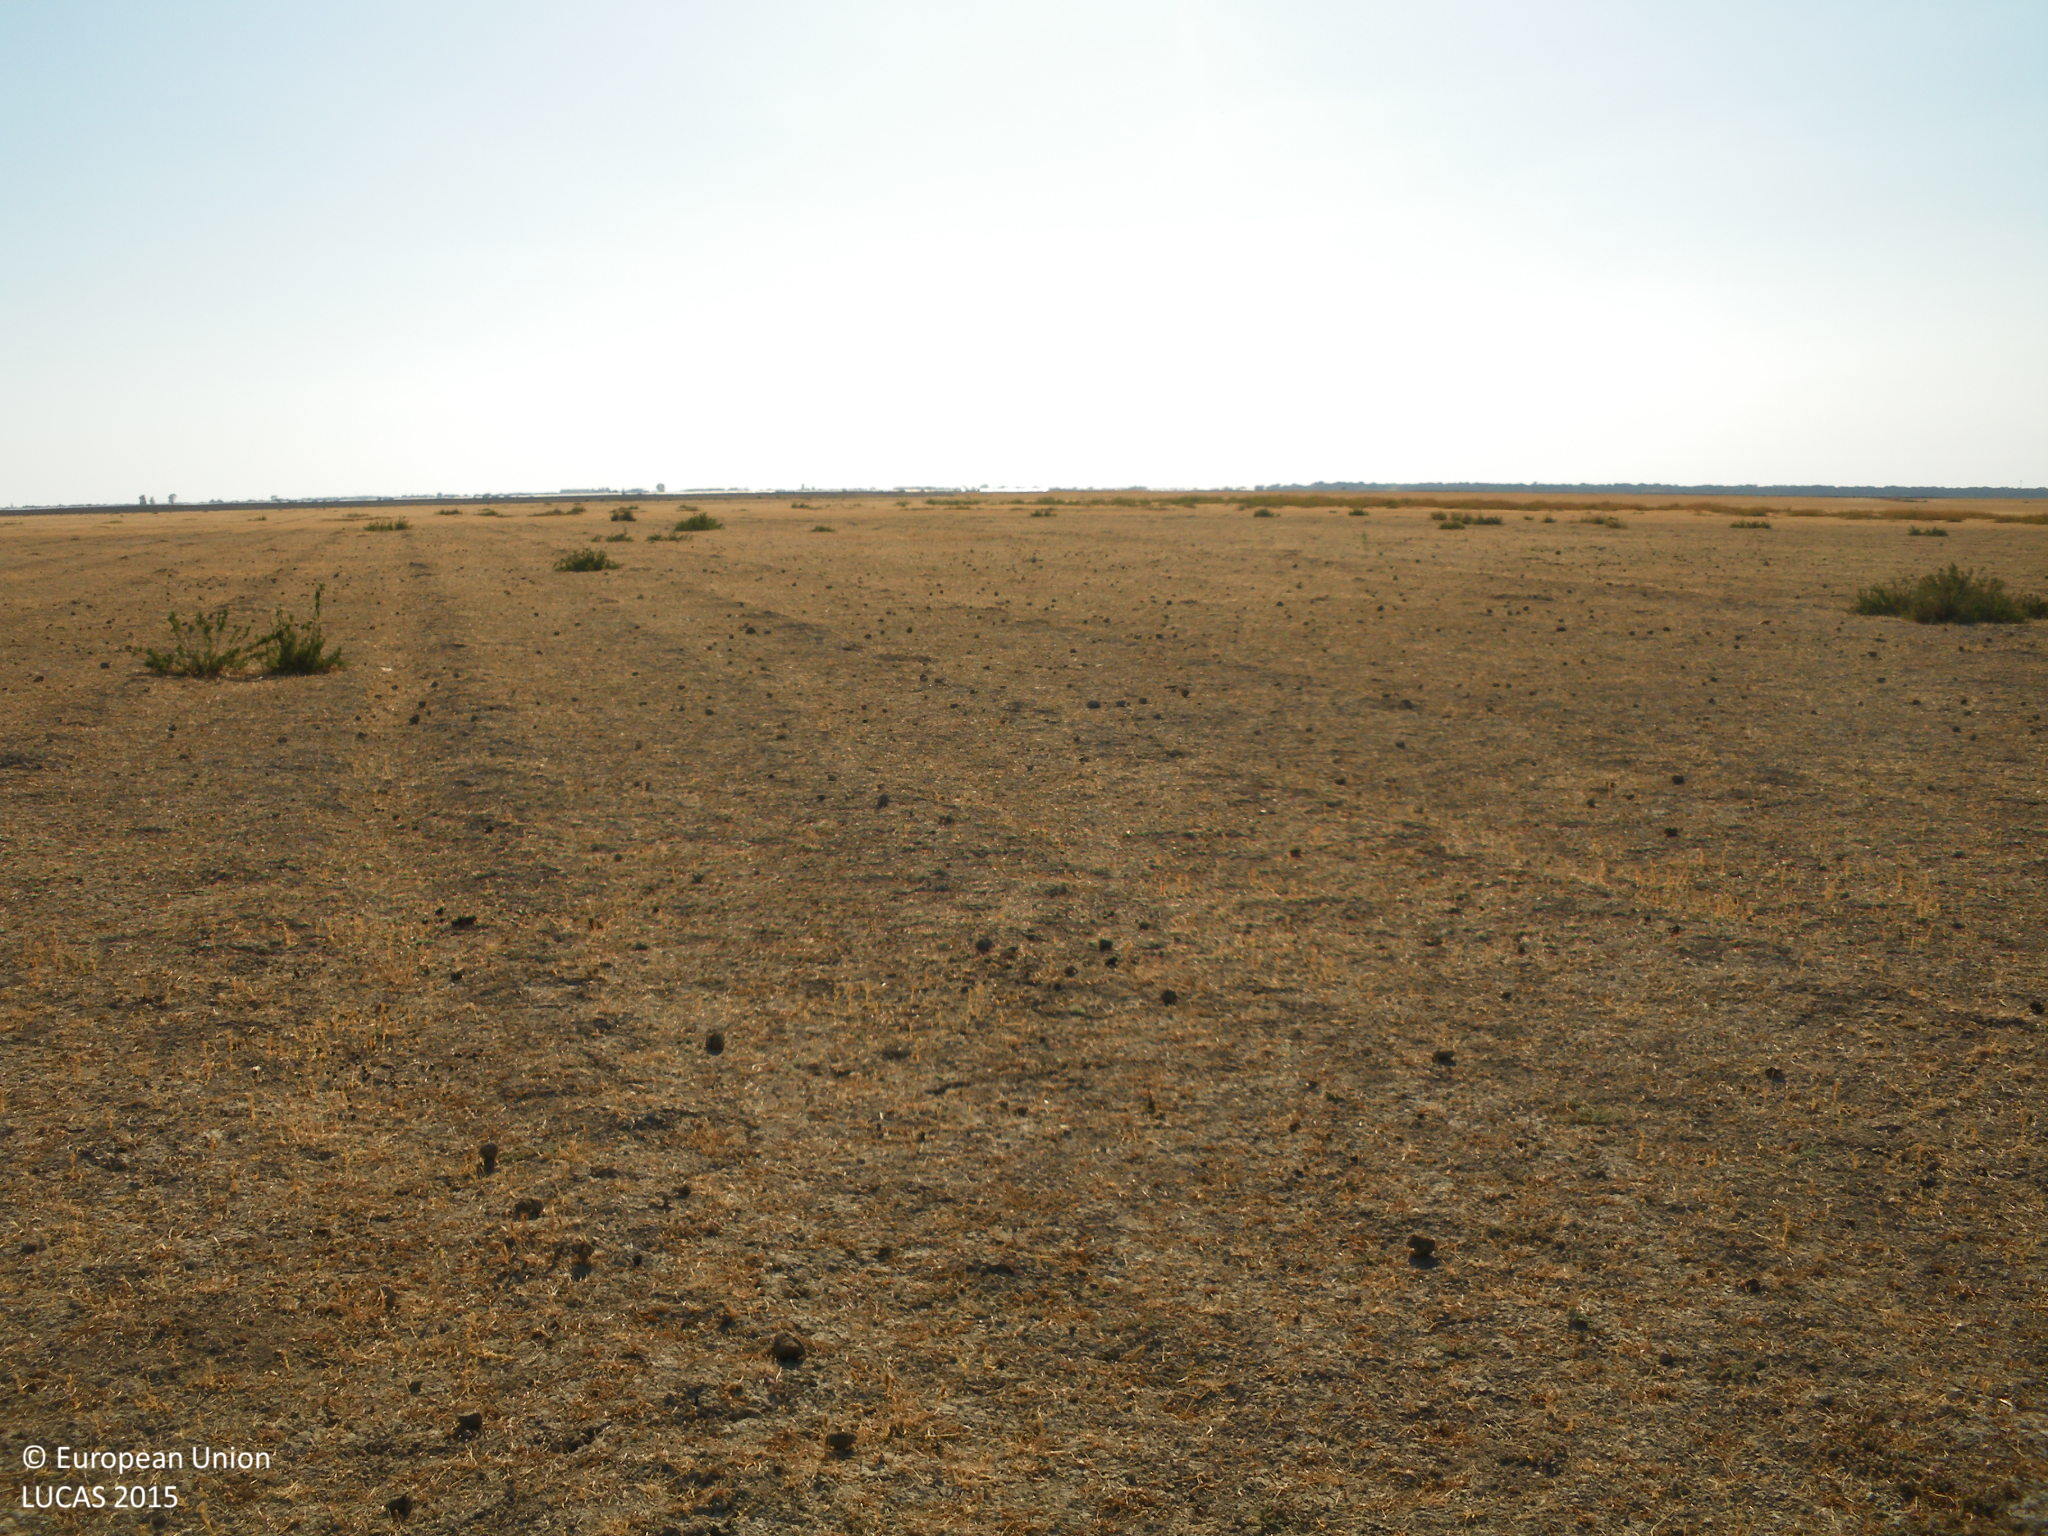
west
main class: Grassland
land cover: Spontaneously vegetated surfaces
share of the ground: > 75 %
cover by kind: herbaceous plants 80 %, unconsolidated bare surface 20 %
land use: Agriculture (excluding fallow land and kitchen gardens)
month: May
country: ES
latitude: 36.8353
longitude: -6.2648
